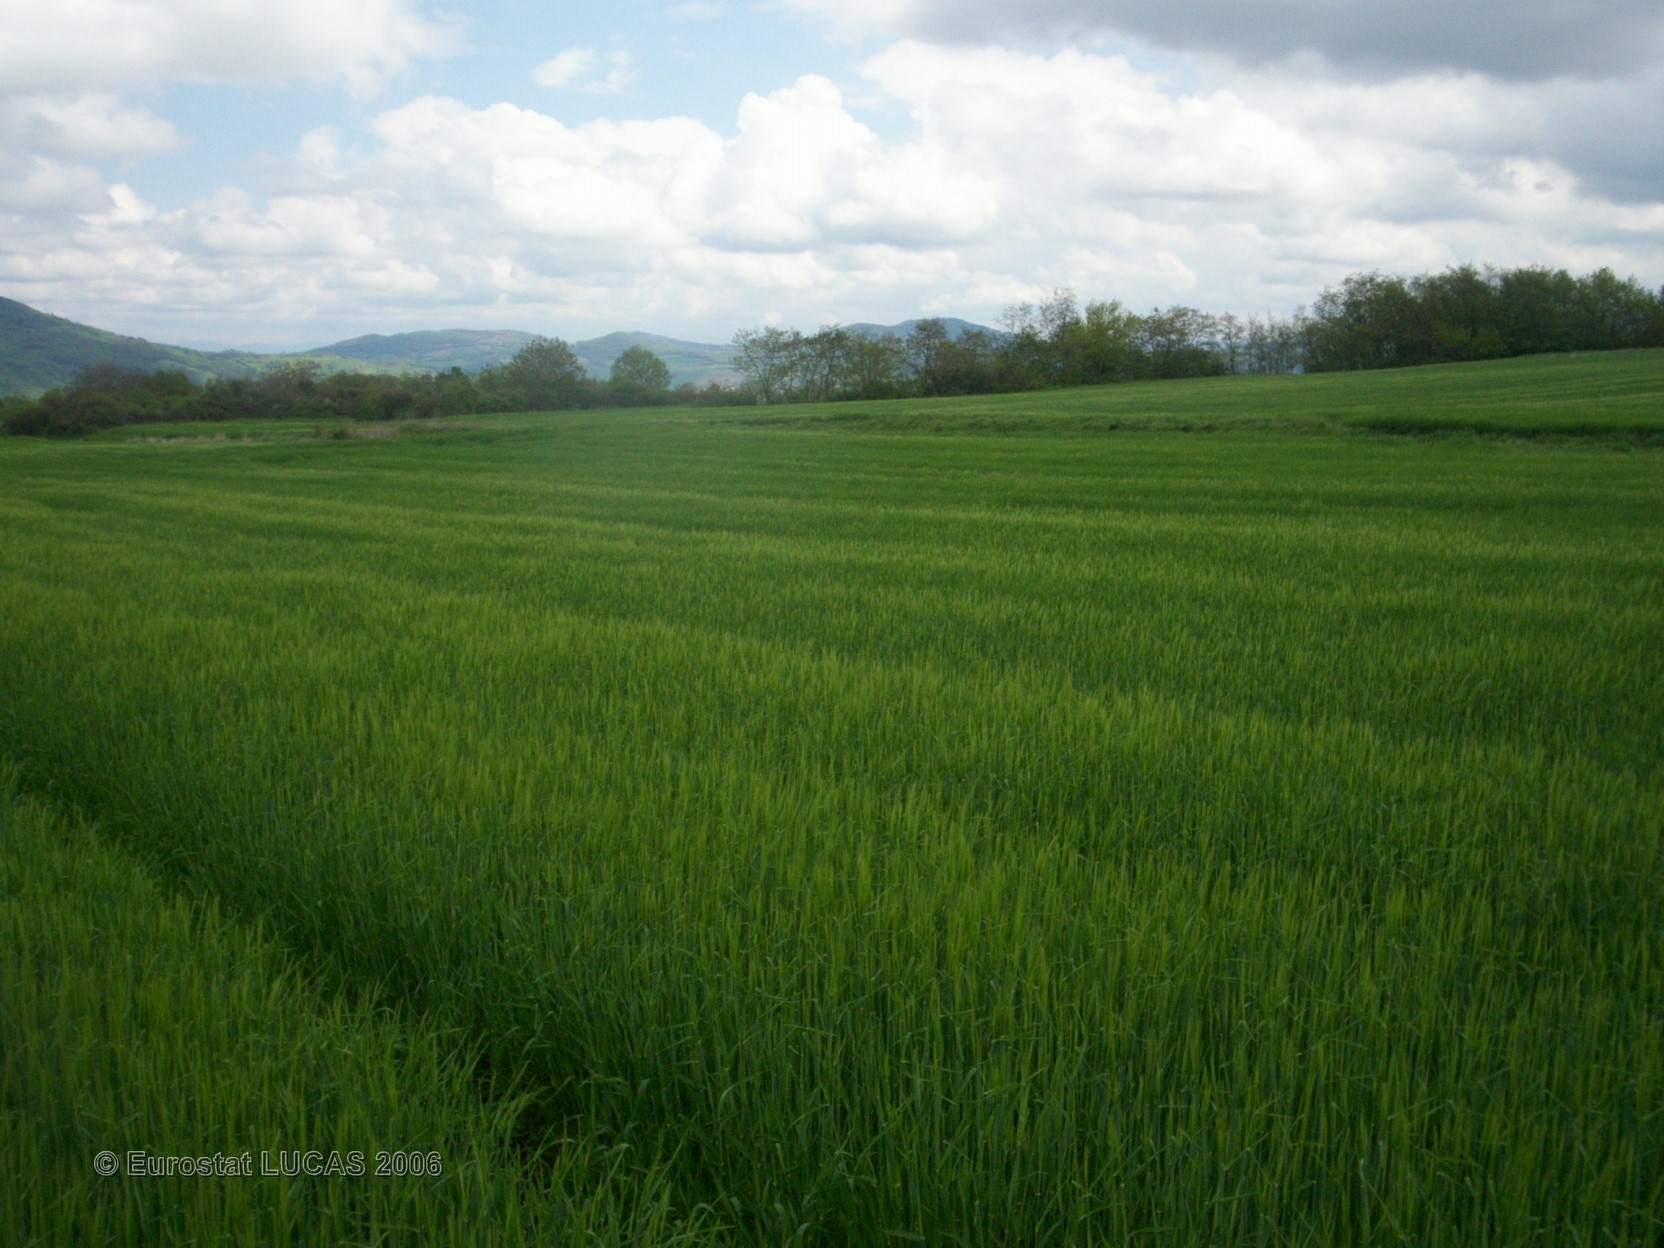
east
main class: Cropland
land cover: Barley
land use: Agriculture (excluding fallow land and kitchen gardens)
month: May
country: FR
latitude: 45.6638
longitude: 3.1850
